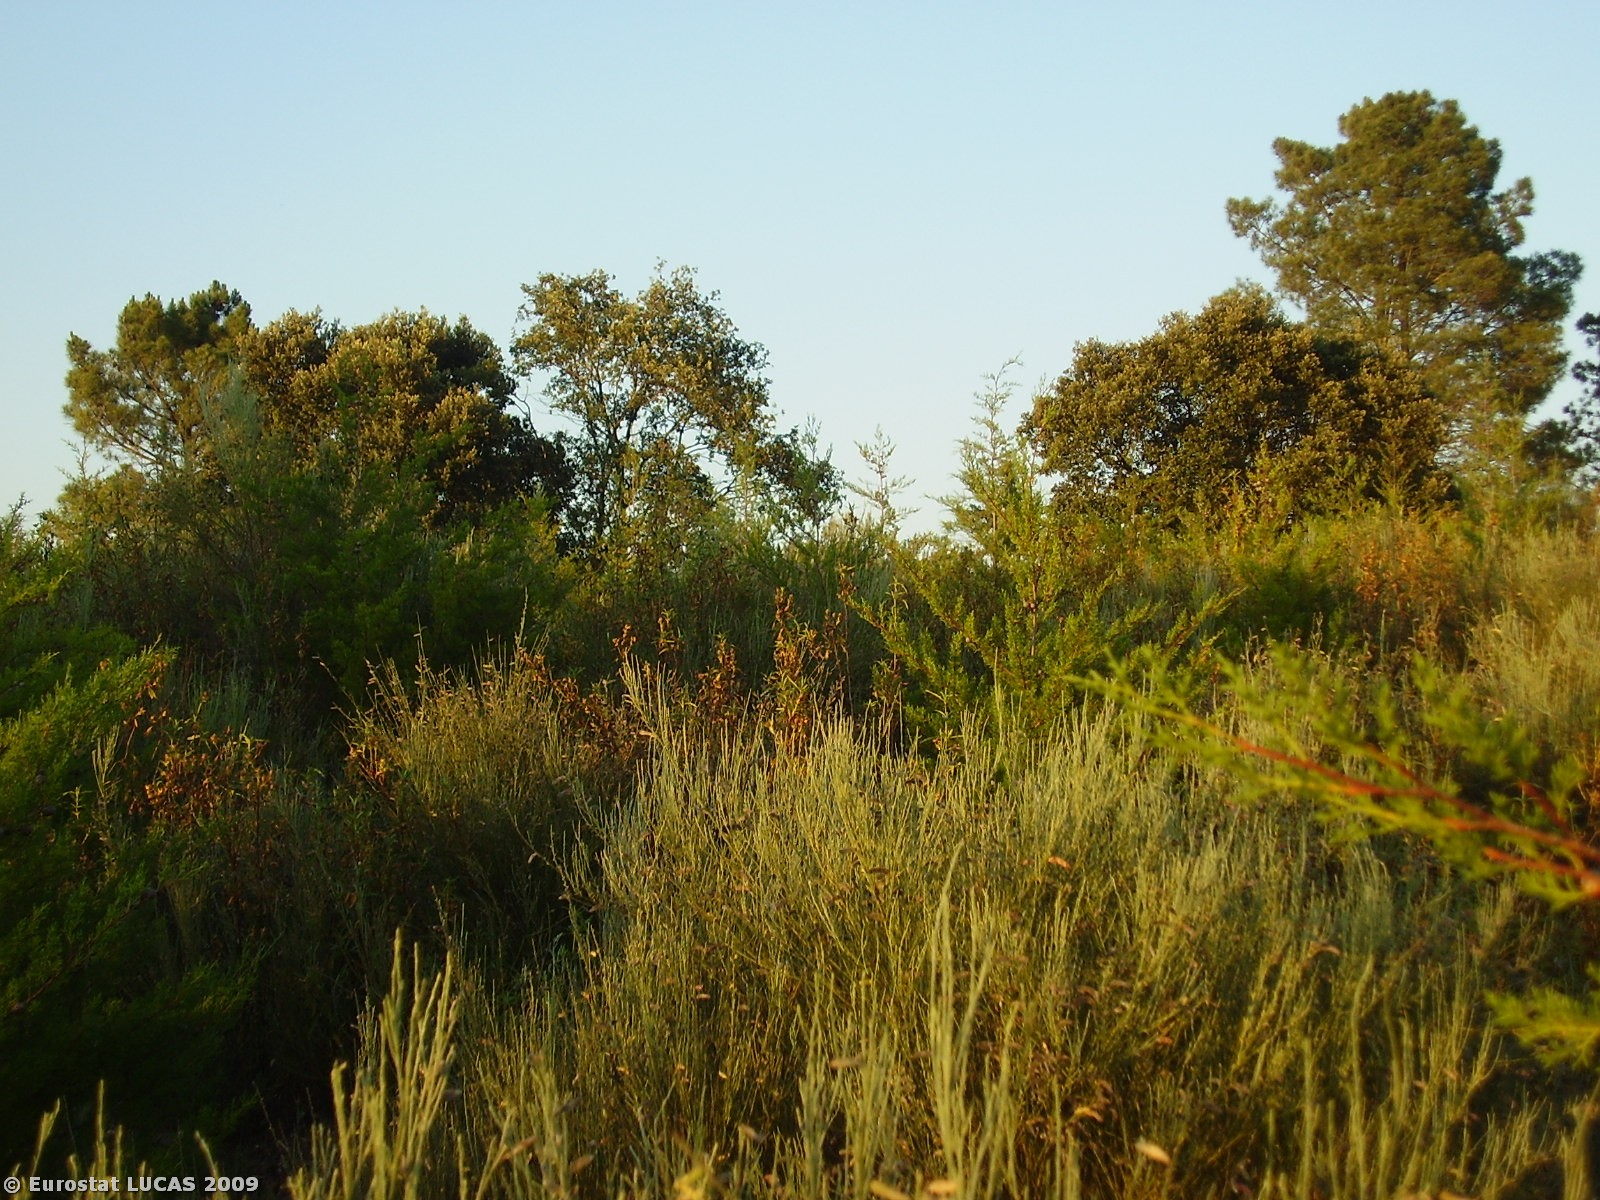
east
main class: Woodland
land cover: Coniferous woodland
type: coniferous forest of the mediterranean region
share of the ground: 10 - 25 %
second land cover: Spontaneously vegetated surfaces
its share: > 75 %
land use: Forestry
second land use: Nature reserves
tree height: > 5 m
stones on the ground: > 50 %
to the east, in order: Coniferous woodland; Spontaneously vegetated surfaces; Coniferous woodland; Bare land; Coniferous woodland; Bare land; Shrubland with sparse tree cover
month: June
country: PT
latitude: 41.5488
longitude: -6.4915
